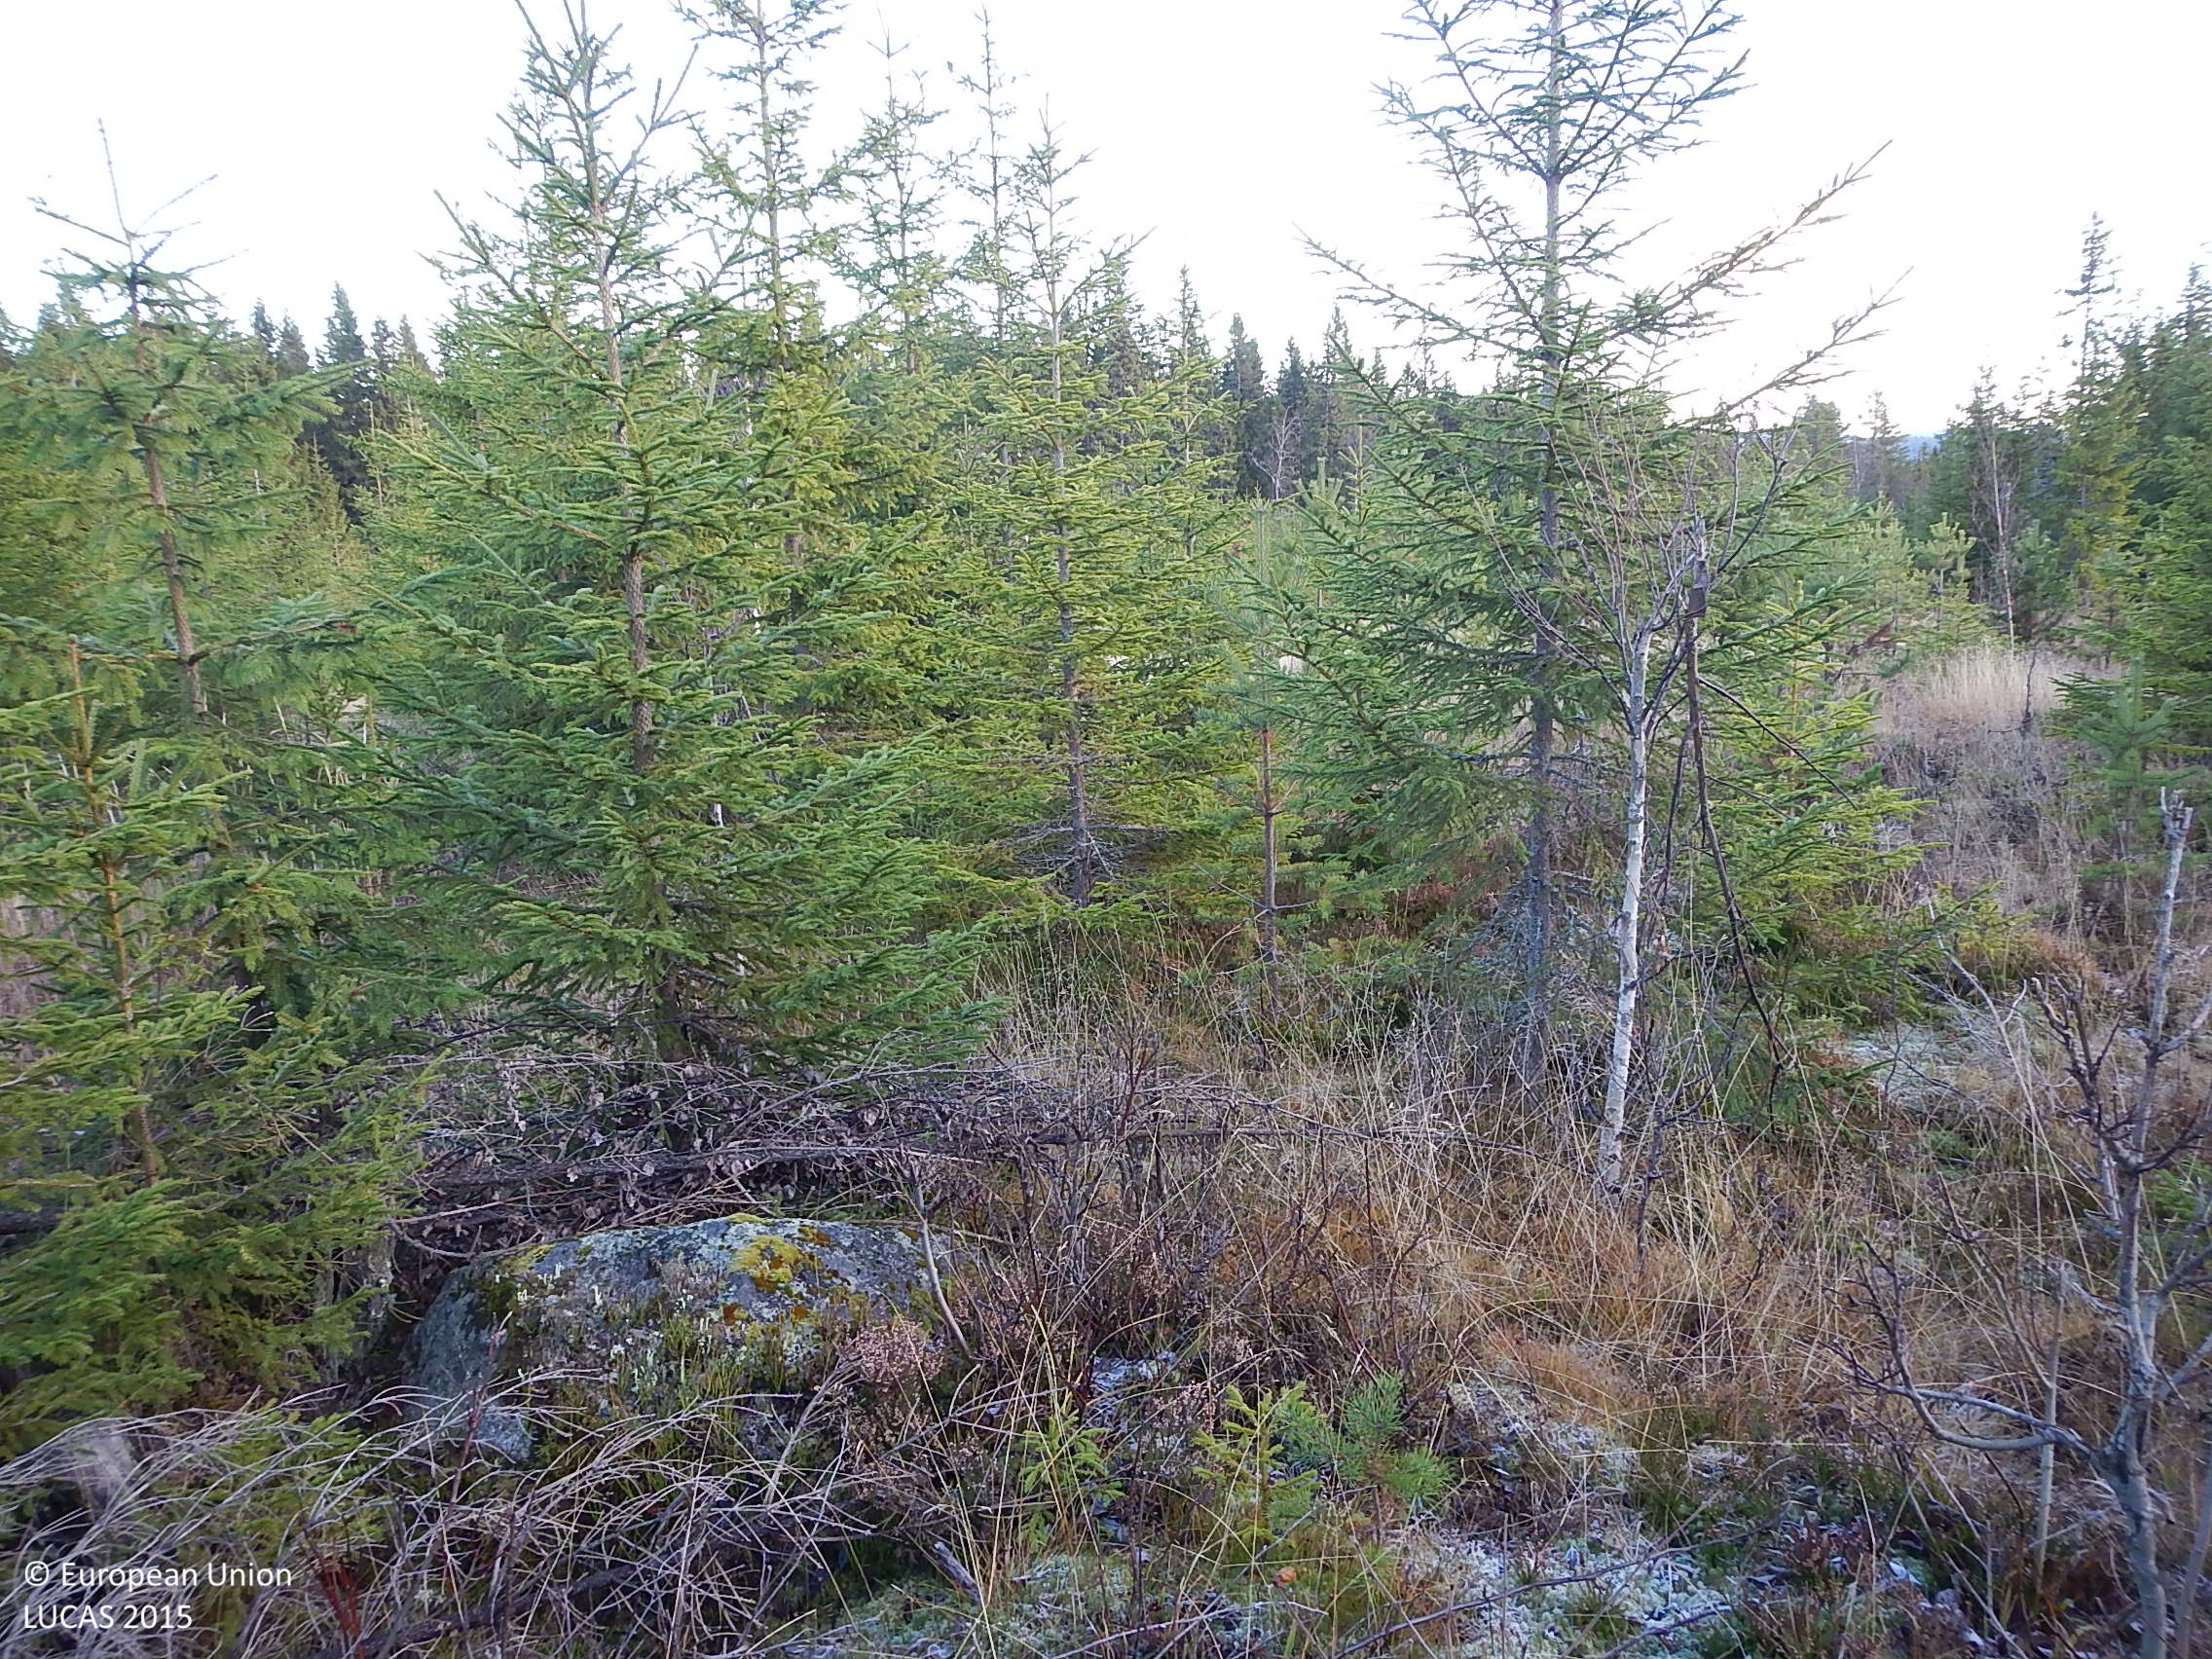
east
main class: Woodland
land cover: Spruce dominated coniferous woodland
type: boreal forest
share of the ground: 25 - 50 %
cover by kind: coniferous forest trees 40 %, shrubs 25 %, herbaceous plants 25 %, lichens and mosses 10 %
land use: Forestry
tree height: < 5 m
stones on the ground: < 10 %
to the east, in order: Spruce dominated coniferous woodland; Ditches and canals; Abandoned hedges; Tracks; Abandoned hedges; Spruce dominated coniferous woodland; Other coniferous woodland
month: November
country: SE
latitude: 61.5649
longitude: 16.1397
